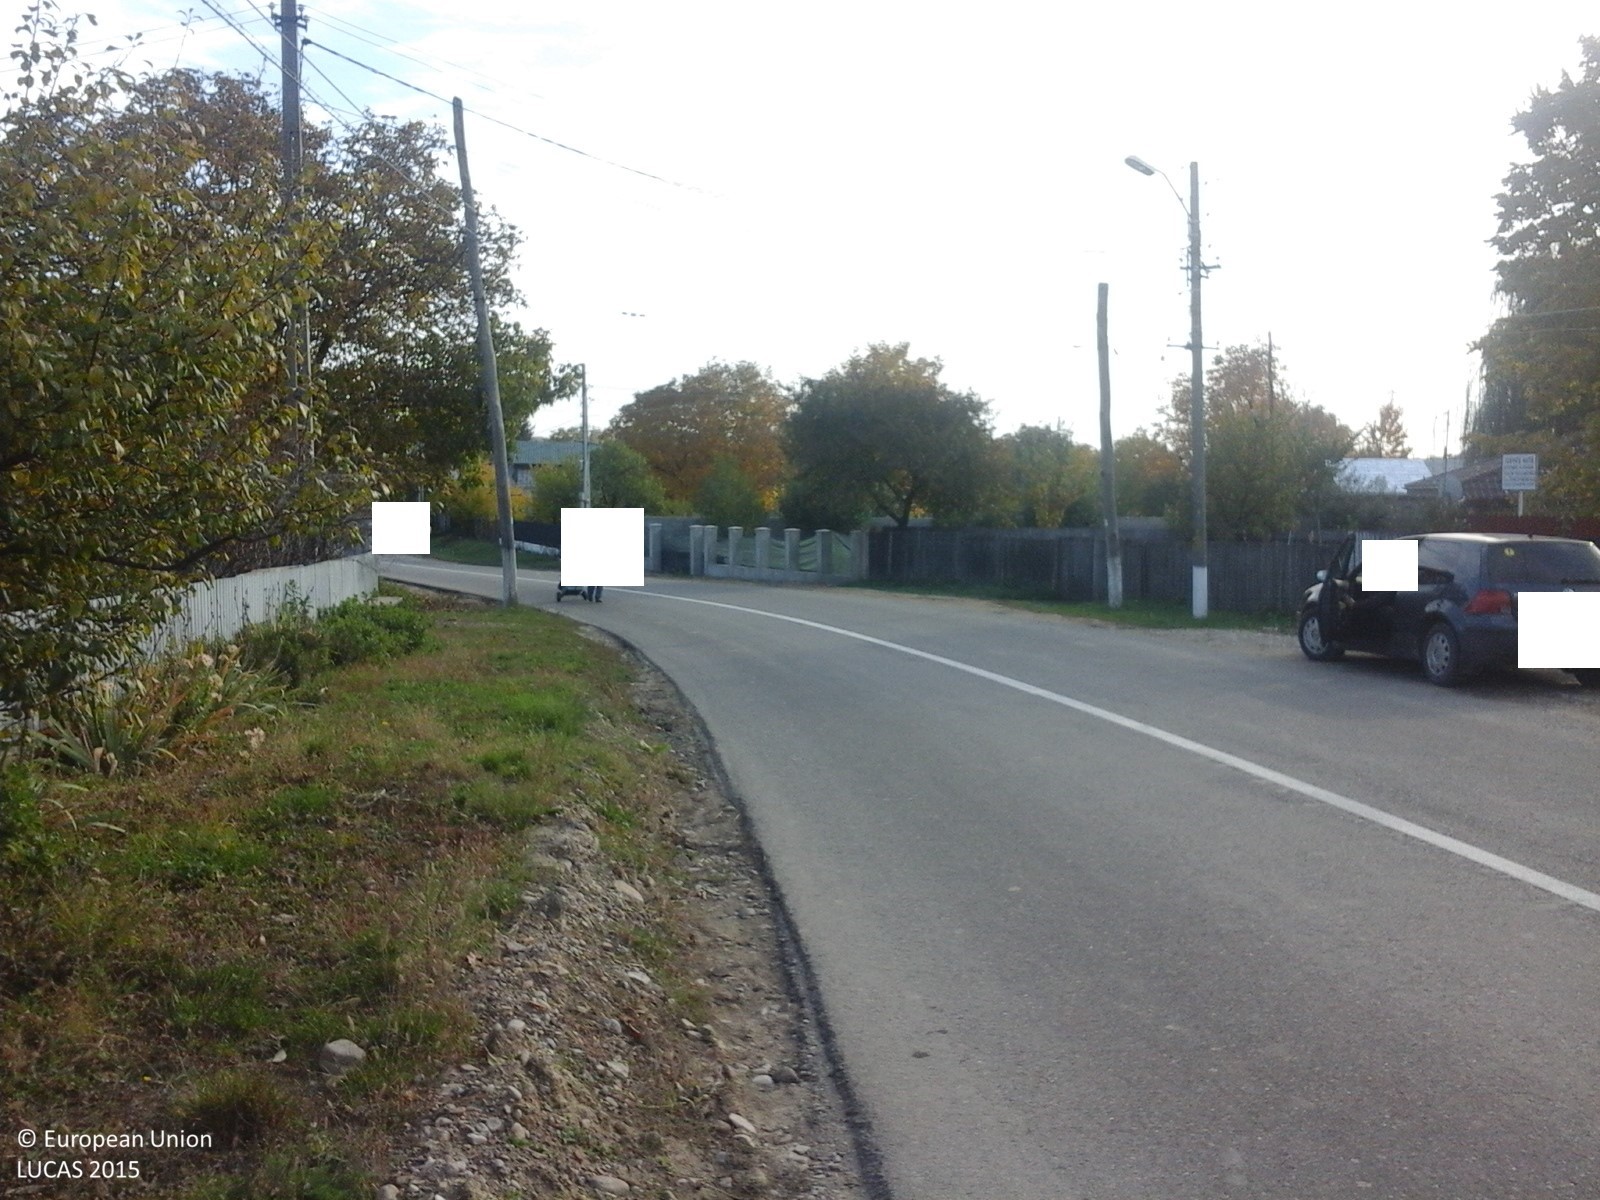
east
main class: Cropland
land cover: Other fresh vegetables
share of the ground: > 75 %
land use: Kitchen garden
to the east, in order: Other fresh vegetables; Artificial constructions in urban areas
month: October
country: RO
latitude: 45.7643
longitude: 27.0247
